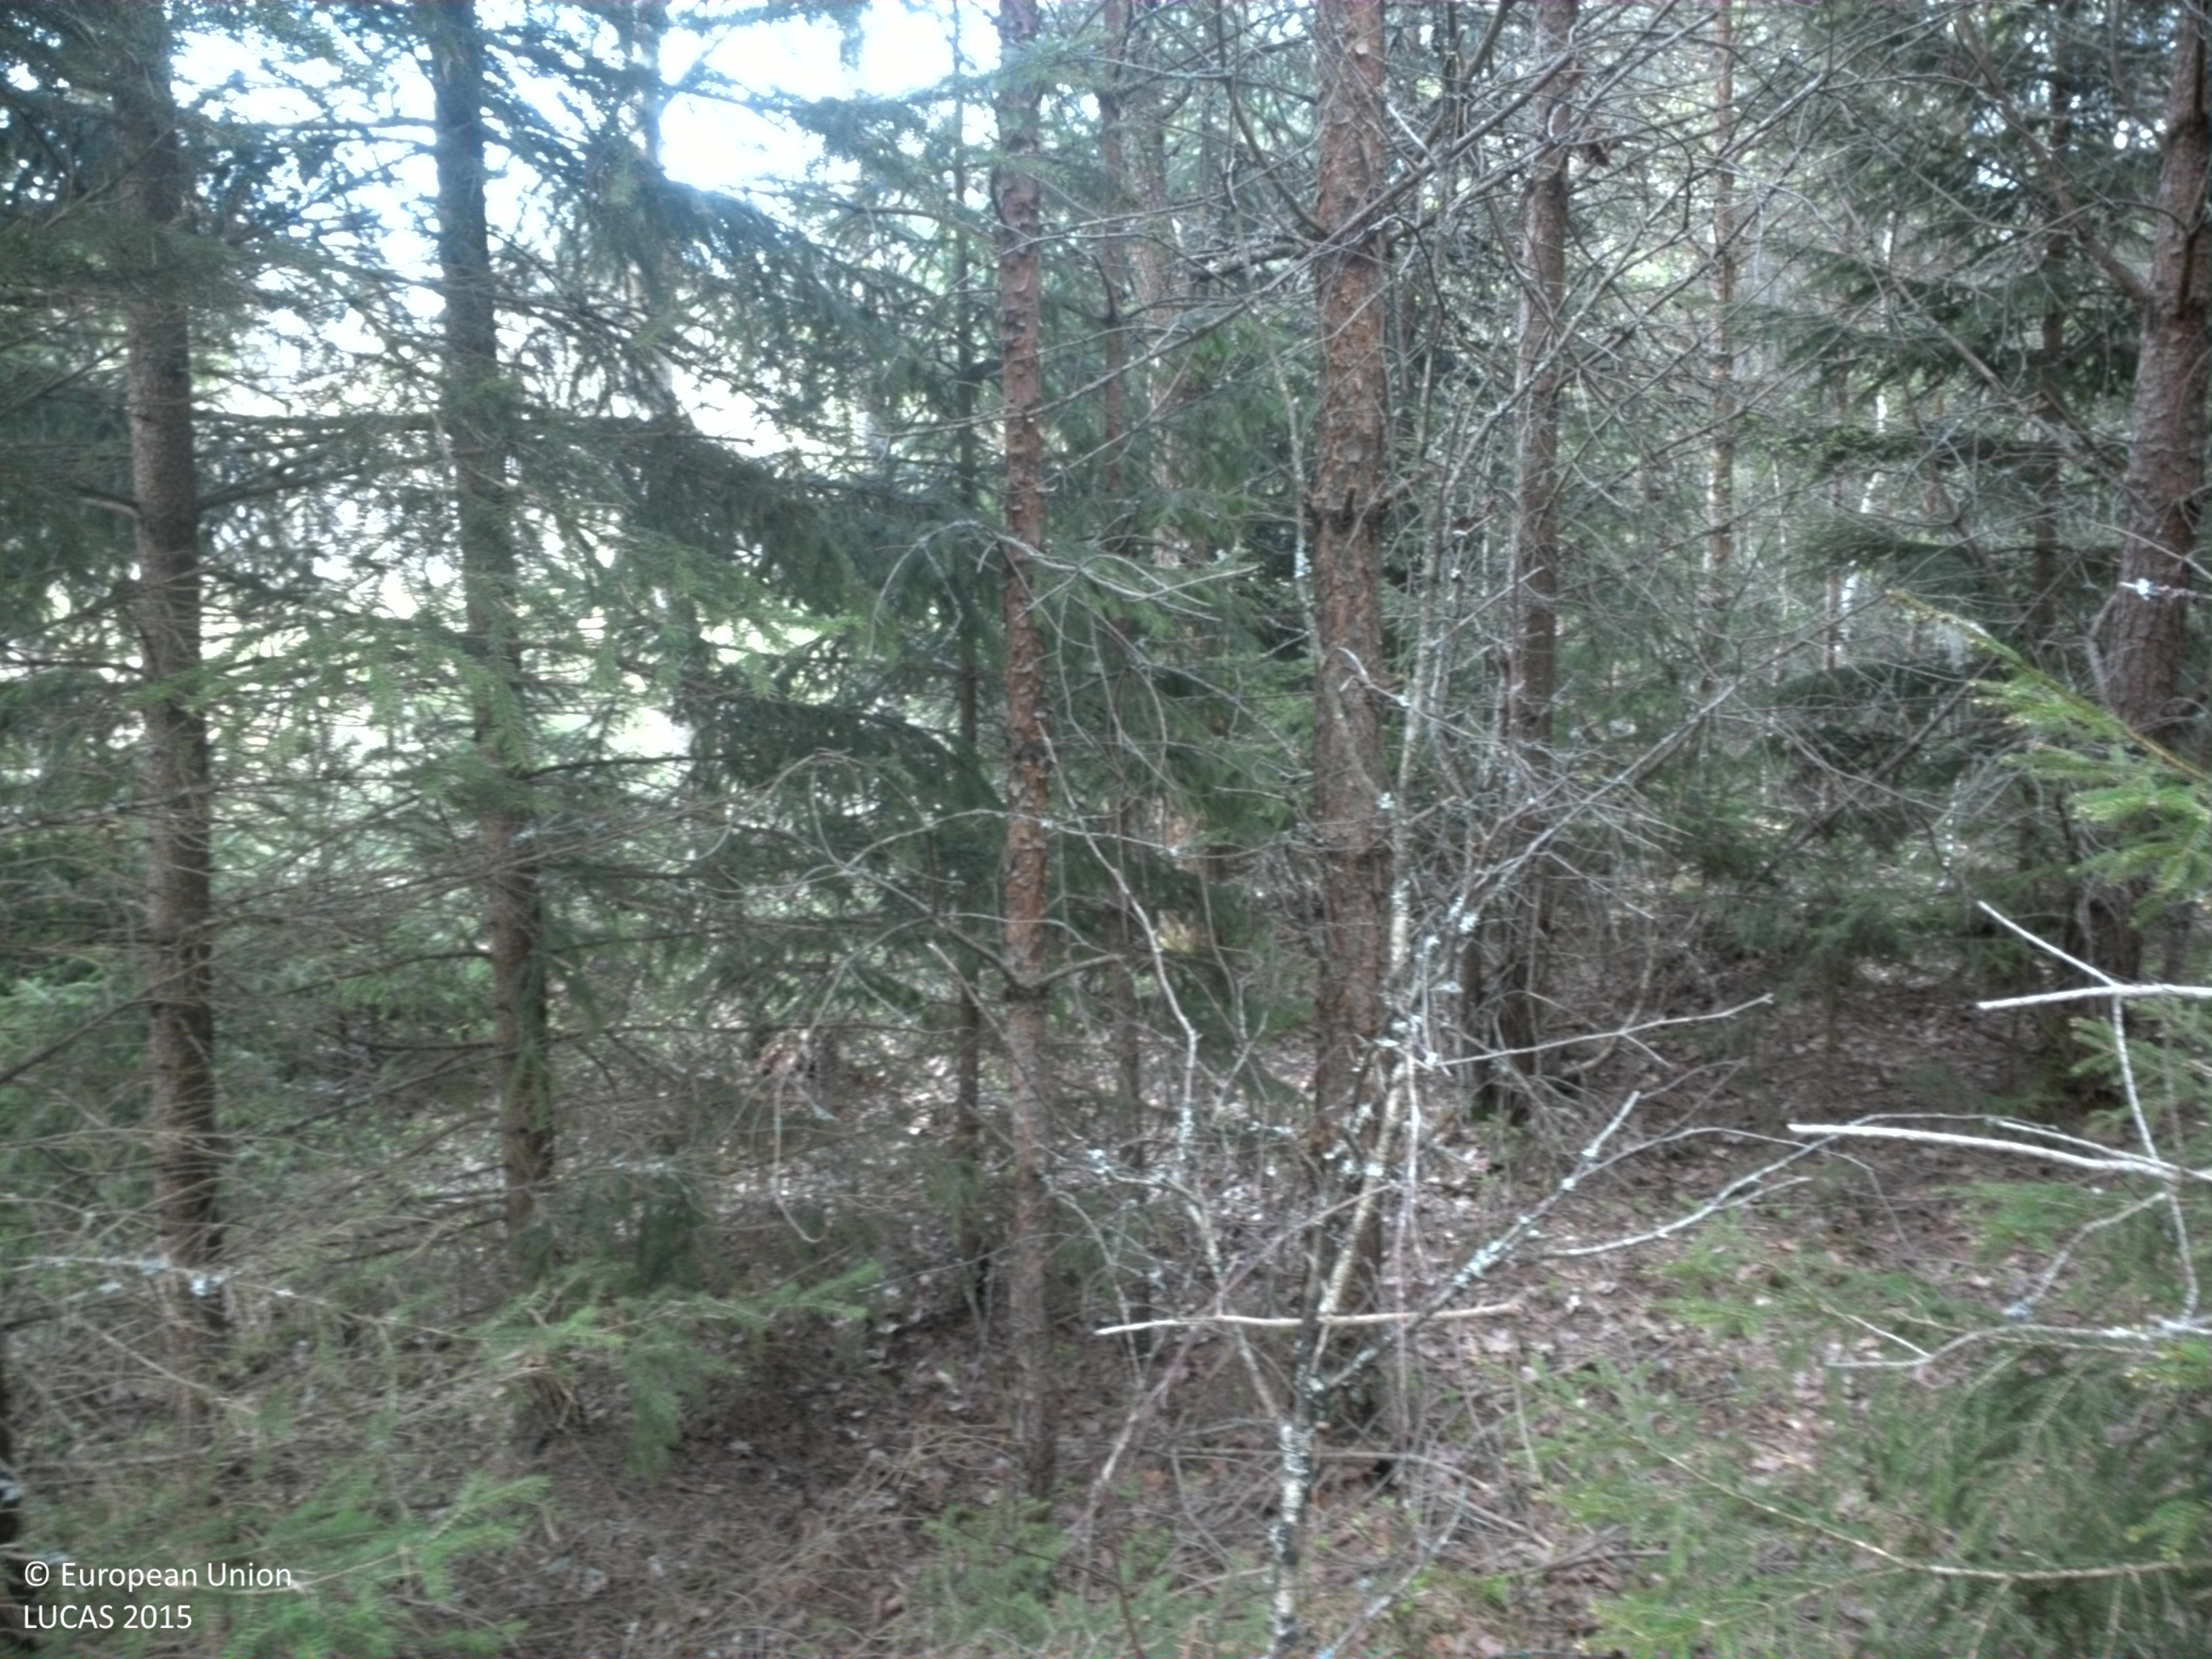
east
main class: Woodland
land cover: Pine dominated coniferous woodland
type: boreal forest
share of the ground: 50 - 75 %
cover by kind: coniferous forest trees 65 %, shrubs 20 %, broadleaved forest trees 10 %, lichens and mosses 5 %
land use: Forestry
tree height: > 5 m
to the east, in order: Pine dominated coniferous woodland; Groves; Inland marshes; Groves; Spruce dominated mixed woodland
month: May
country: SE
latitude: 56.6205
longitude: 15.2623
